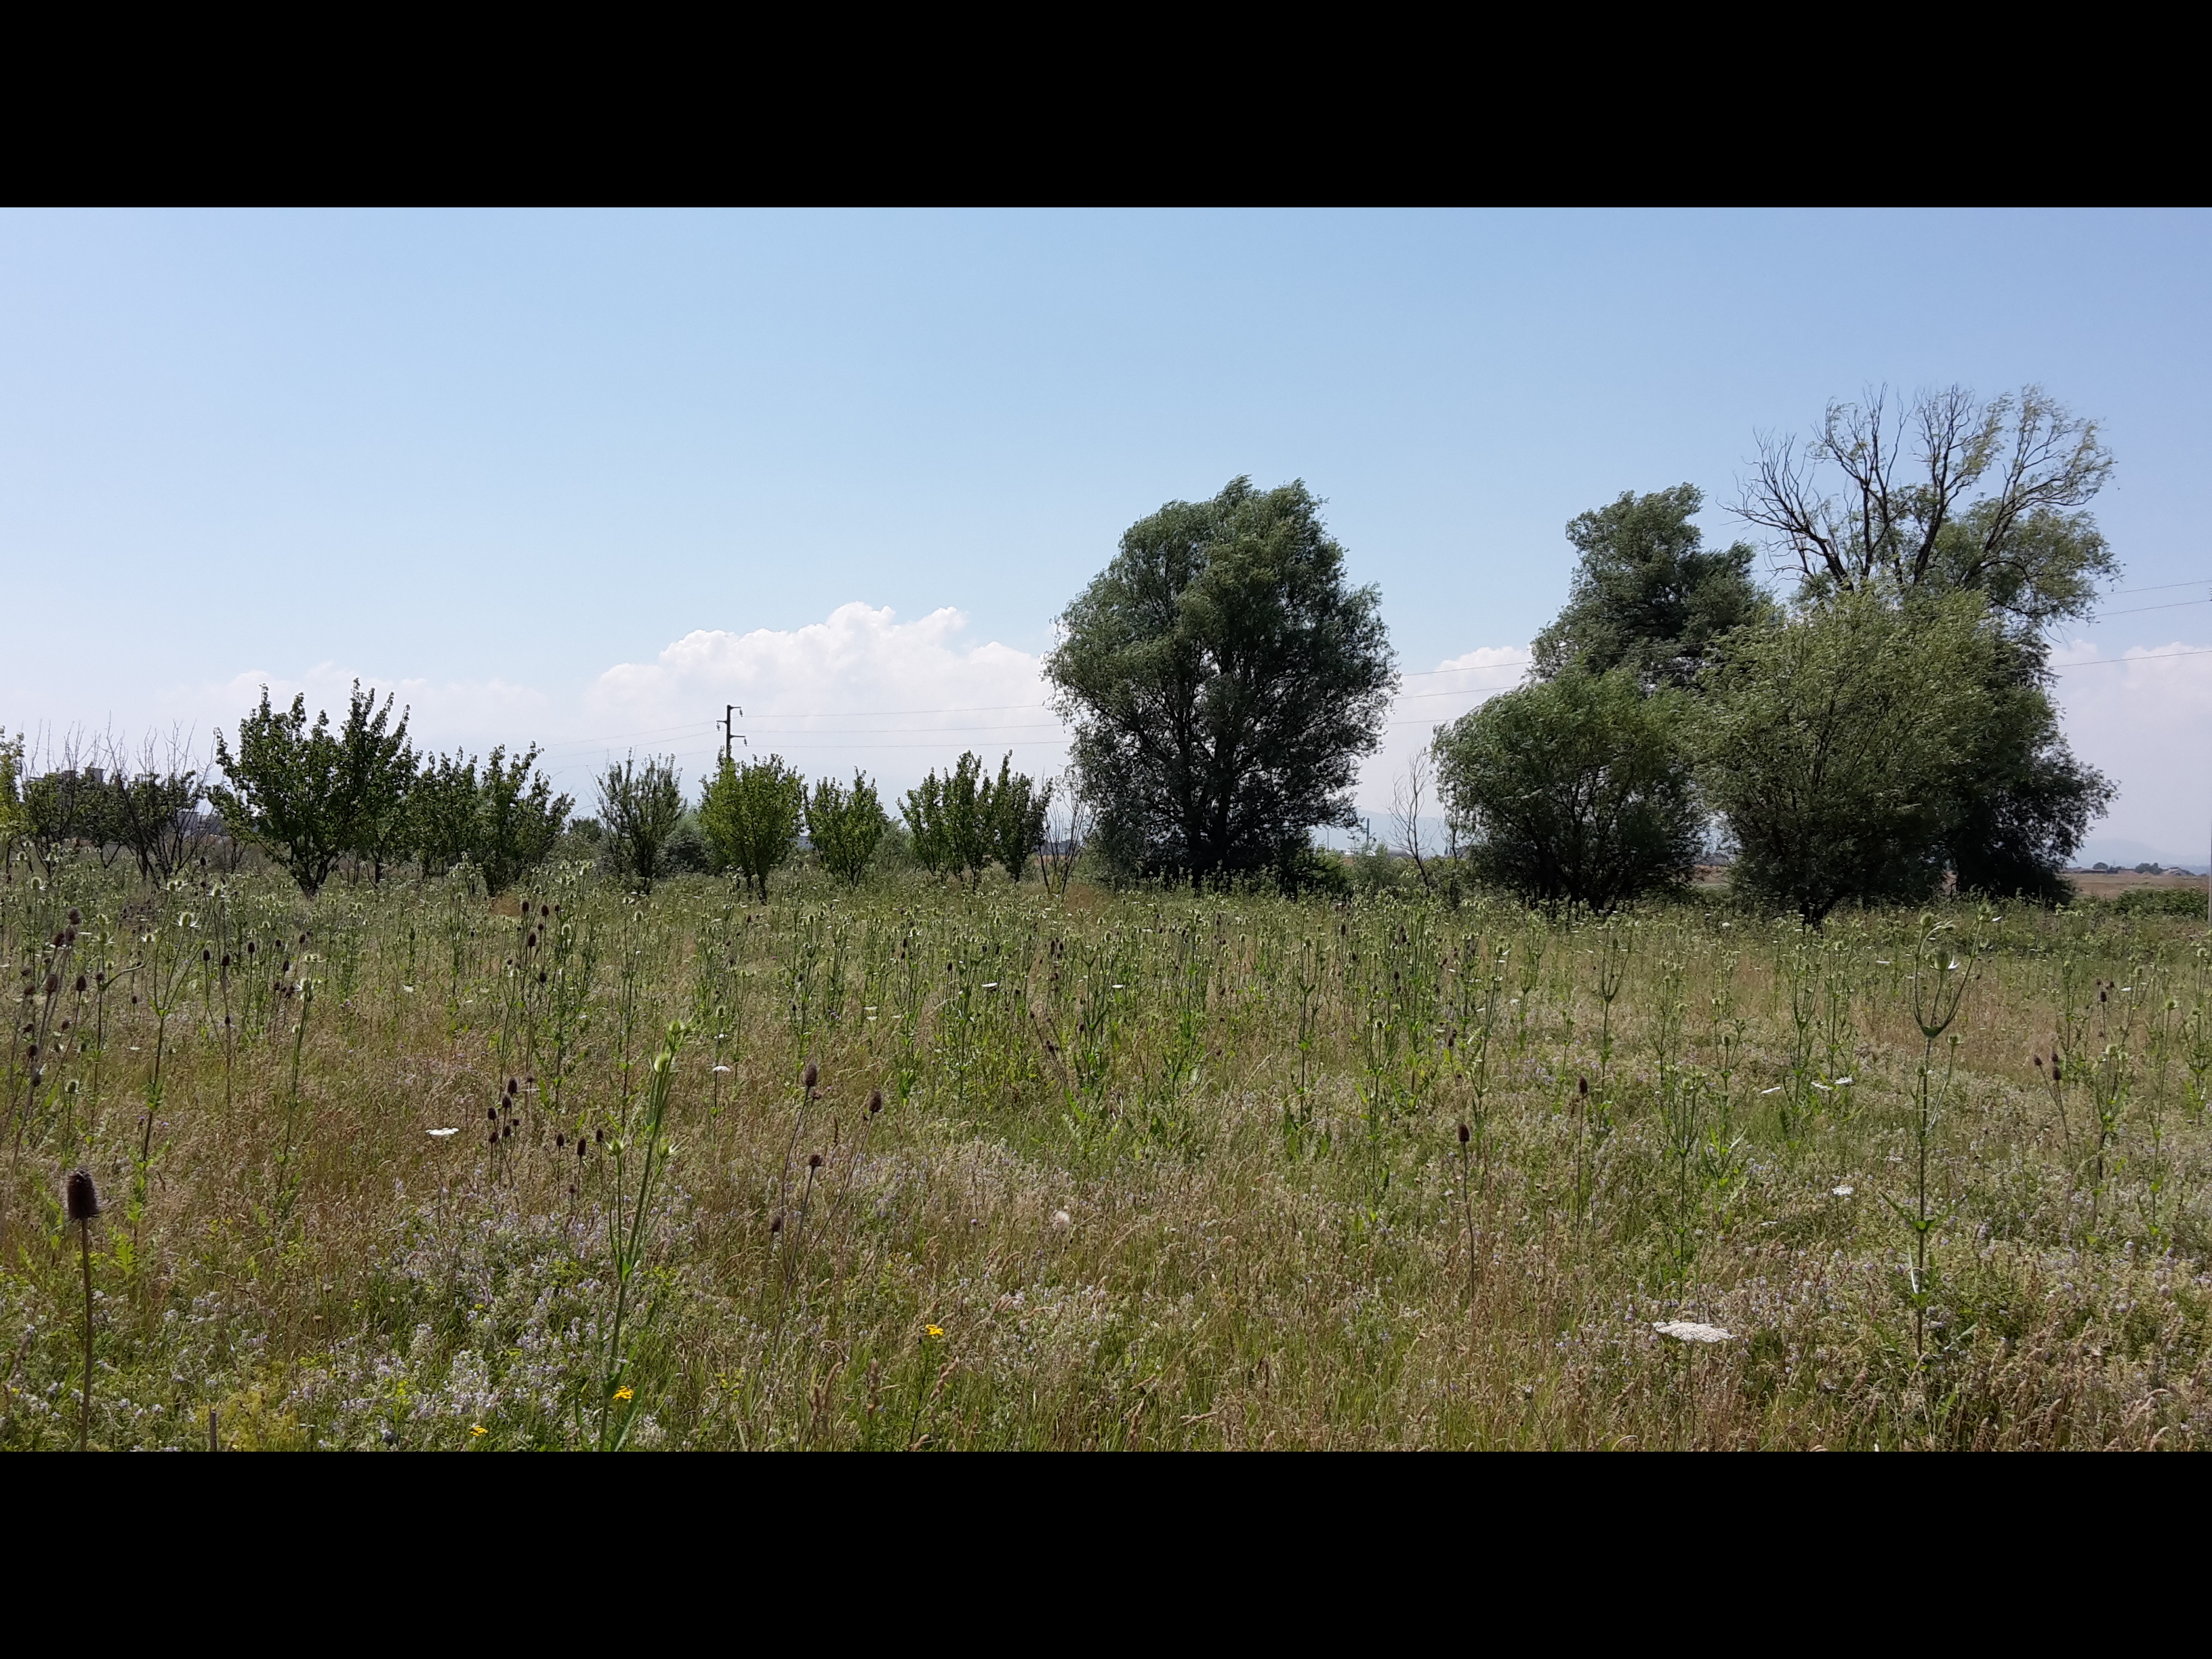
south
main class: Grassland
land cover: Grassland without tree/shrub cover
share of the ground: > 75 %
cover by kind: herbaceous plants 100 %
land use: Semi-natural and natural areas not in use
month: July
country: BG
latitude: 42.8263
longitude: 23.2081
